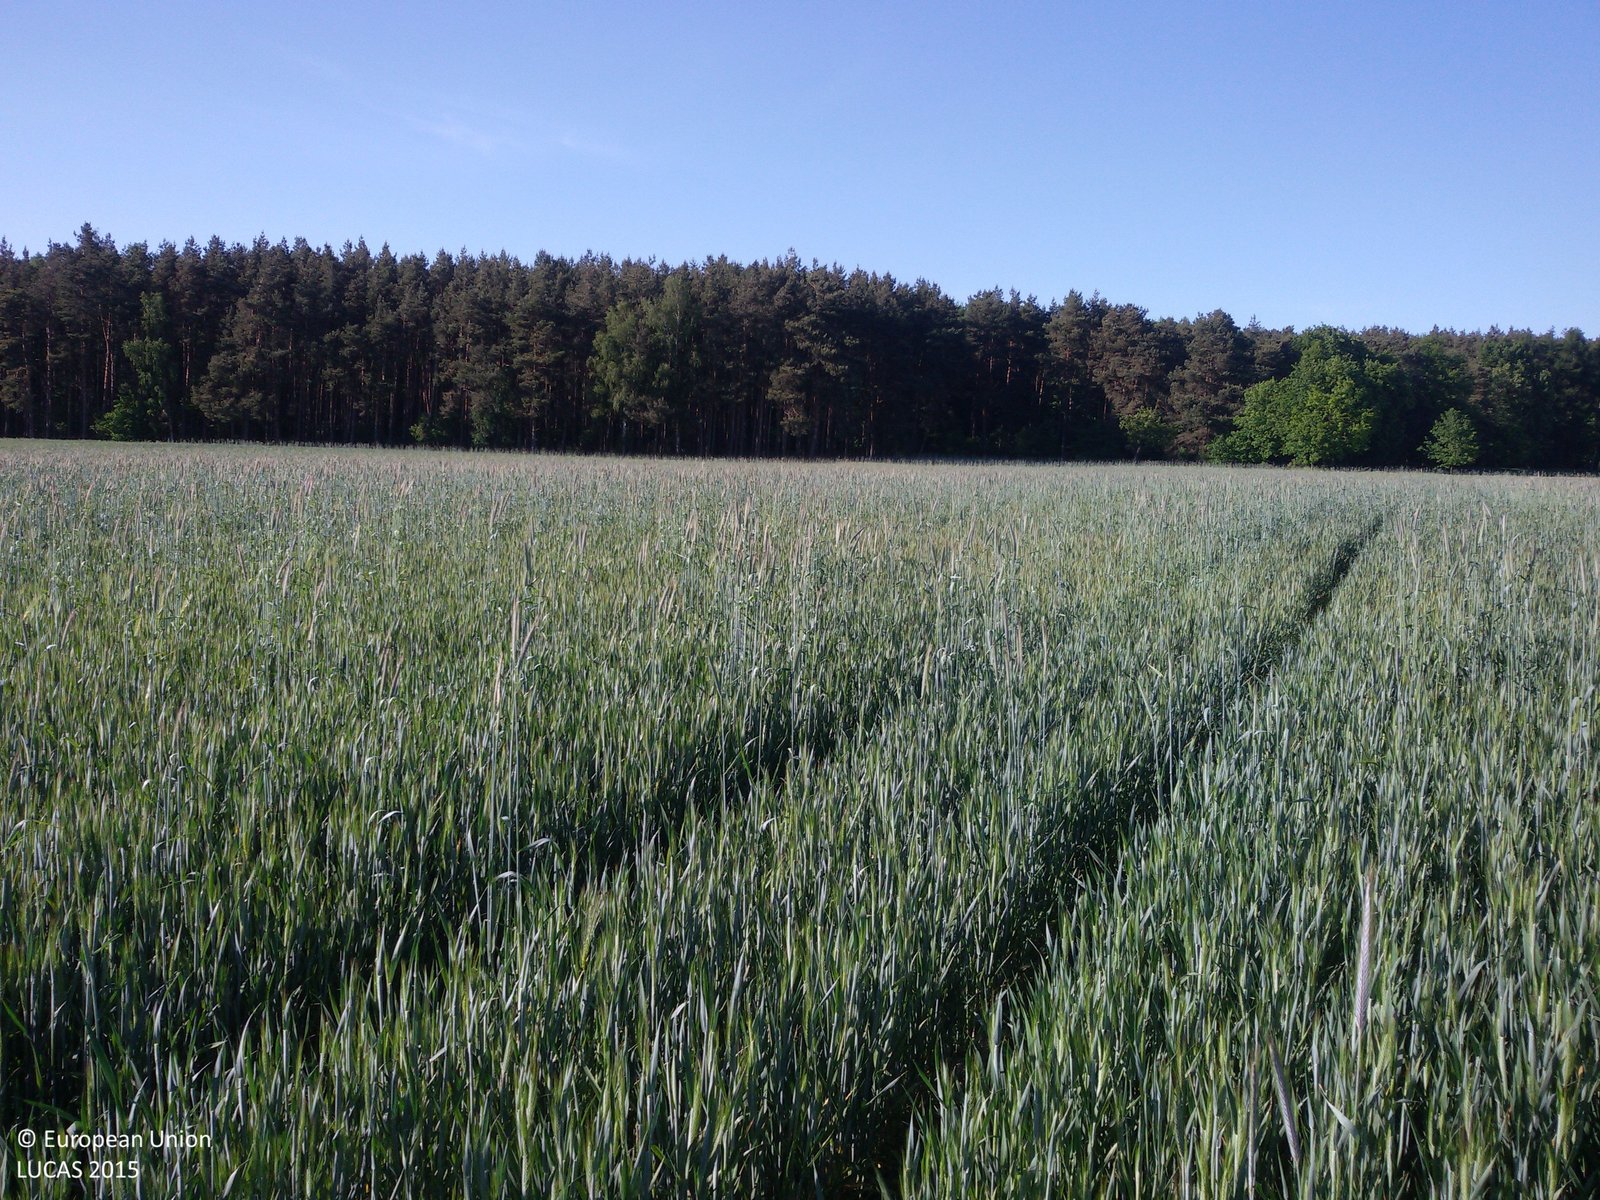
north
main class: Cropland
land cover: Triticale
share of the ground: > 75 %
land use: Agriculture (excluding fallow land and kitchen gardens)
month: May
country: PL
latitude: 53.1244
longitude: 17.0480
